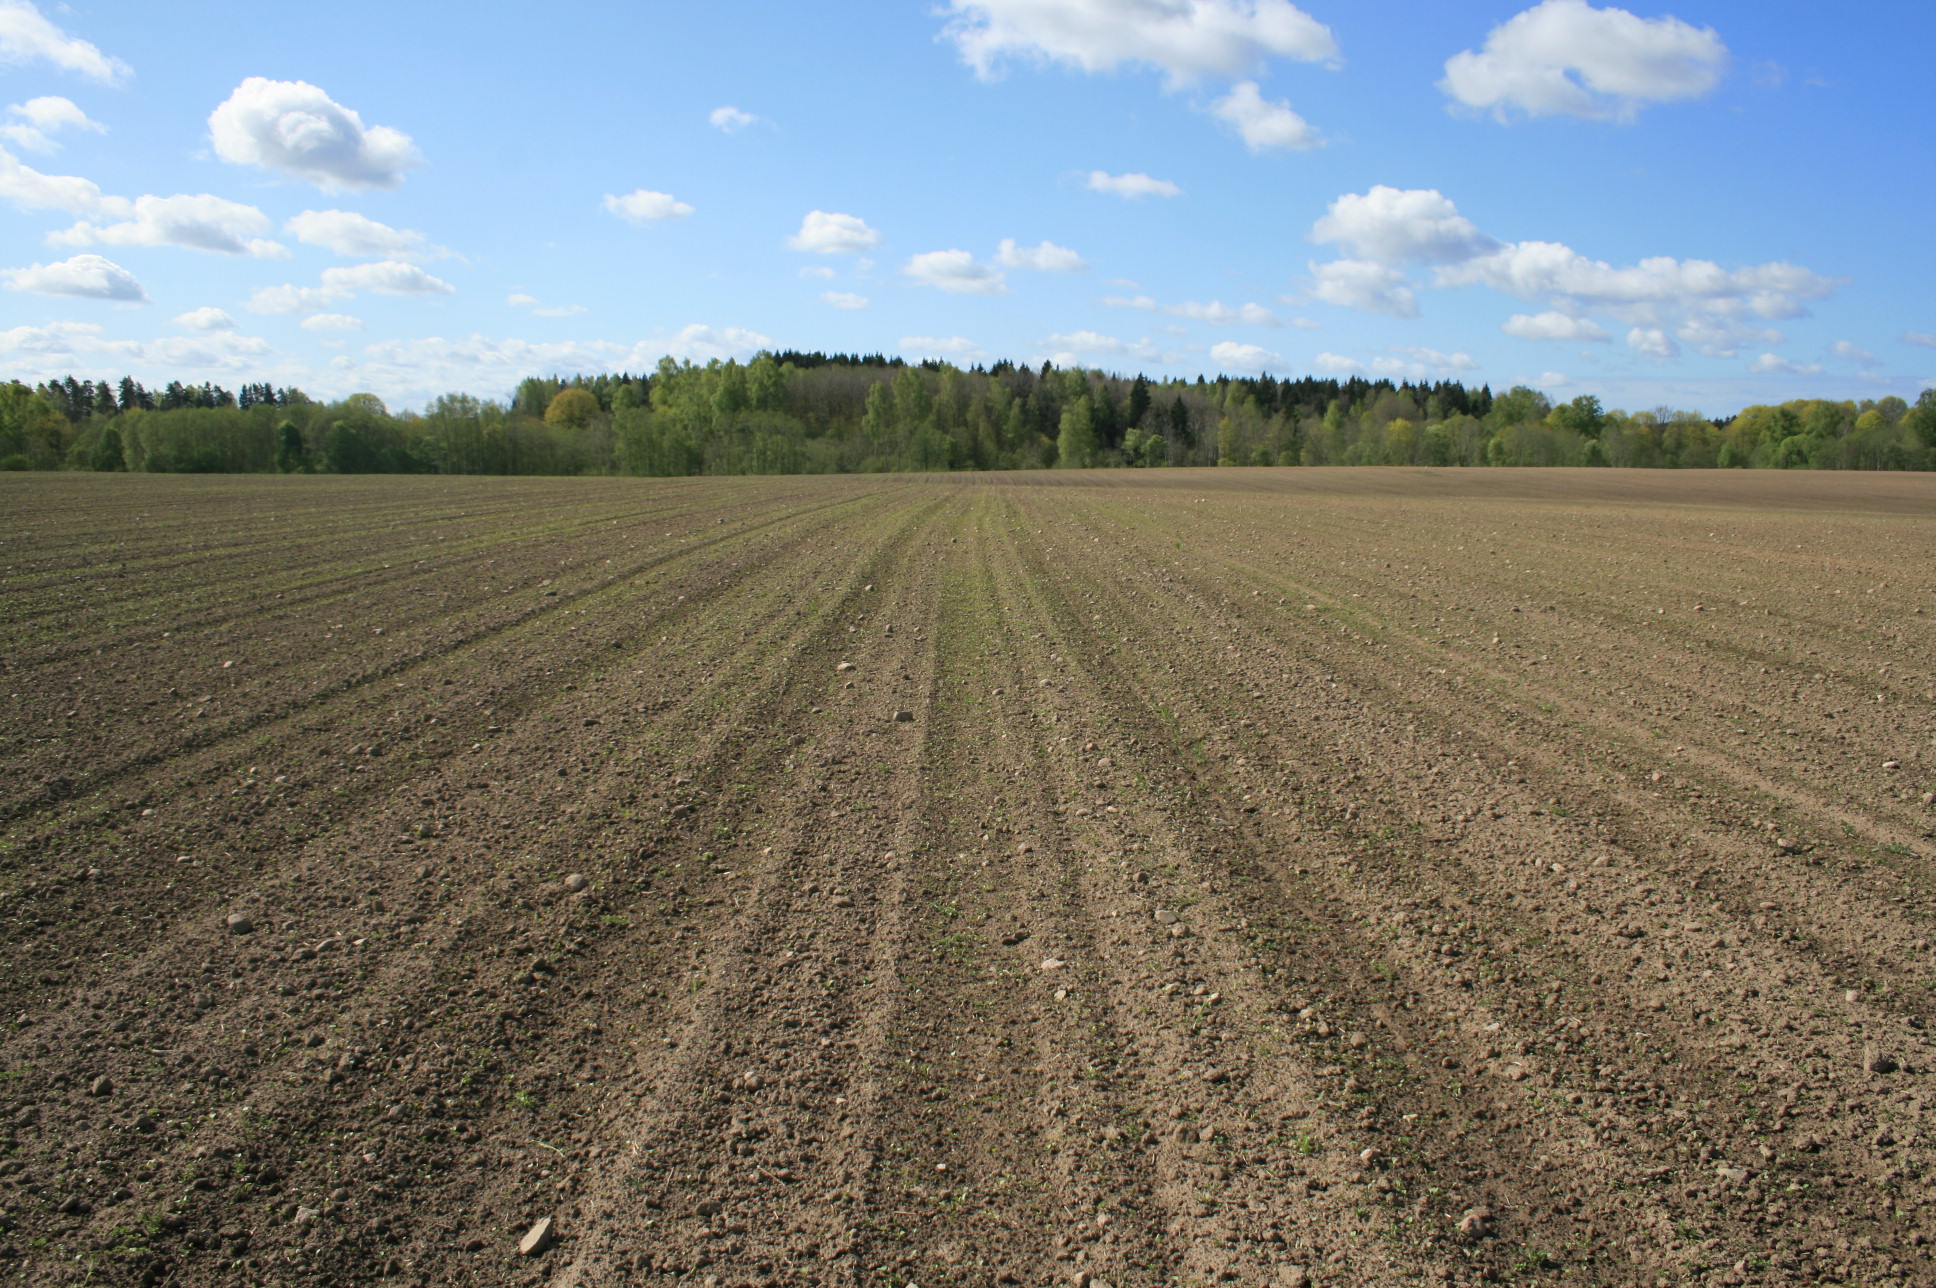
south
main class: Cropland
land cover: Dry pulses
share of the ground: < 10 %
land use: Agriculture (excluding fallow land and kitchen gardens)
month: May
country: LT
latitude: 56.2284
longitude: 21.5447
